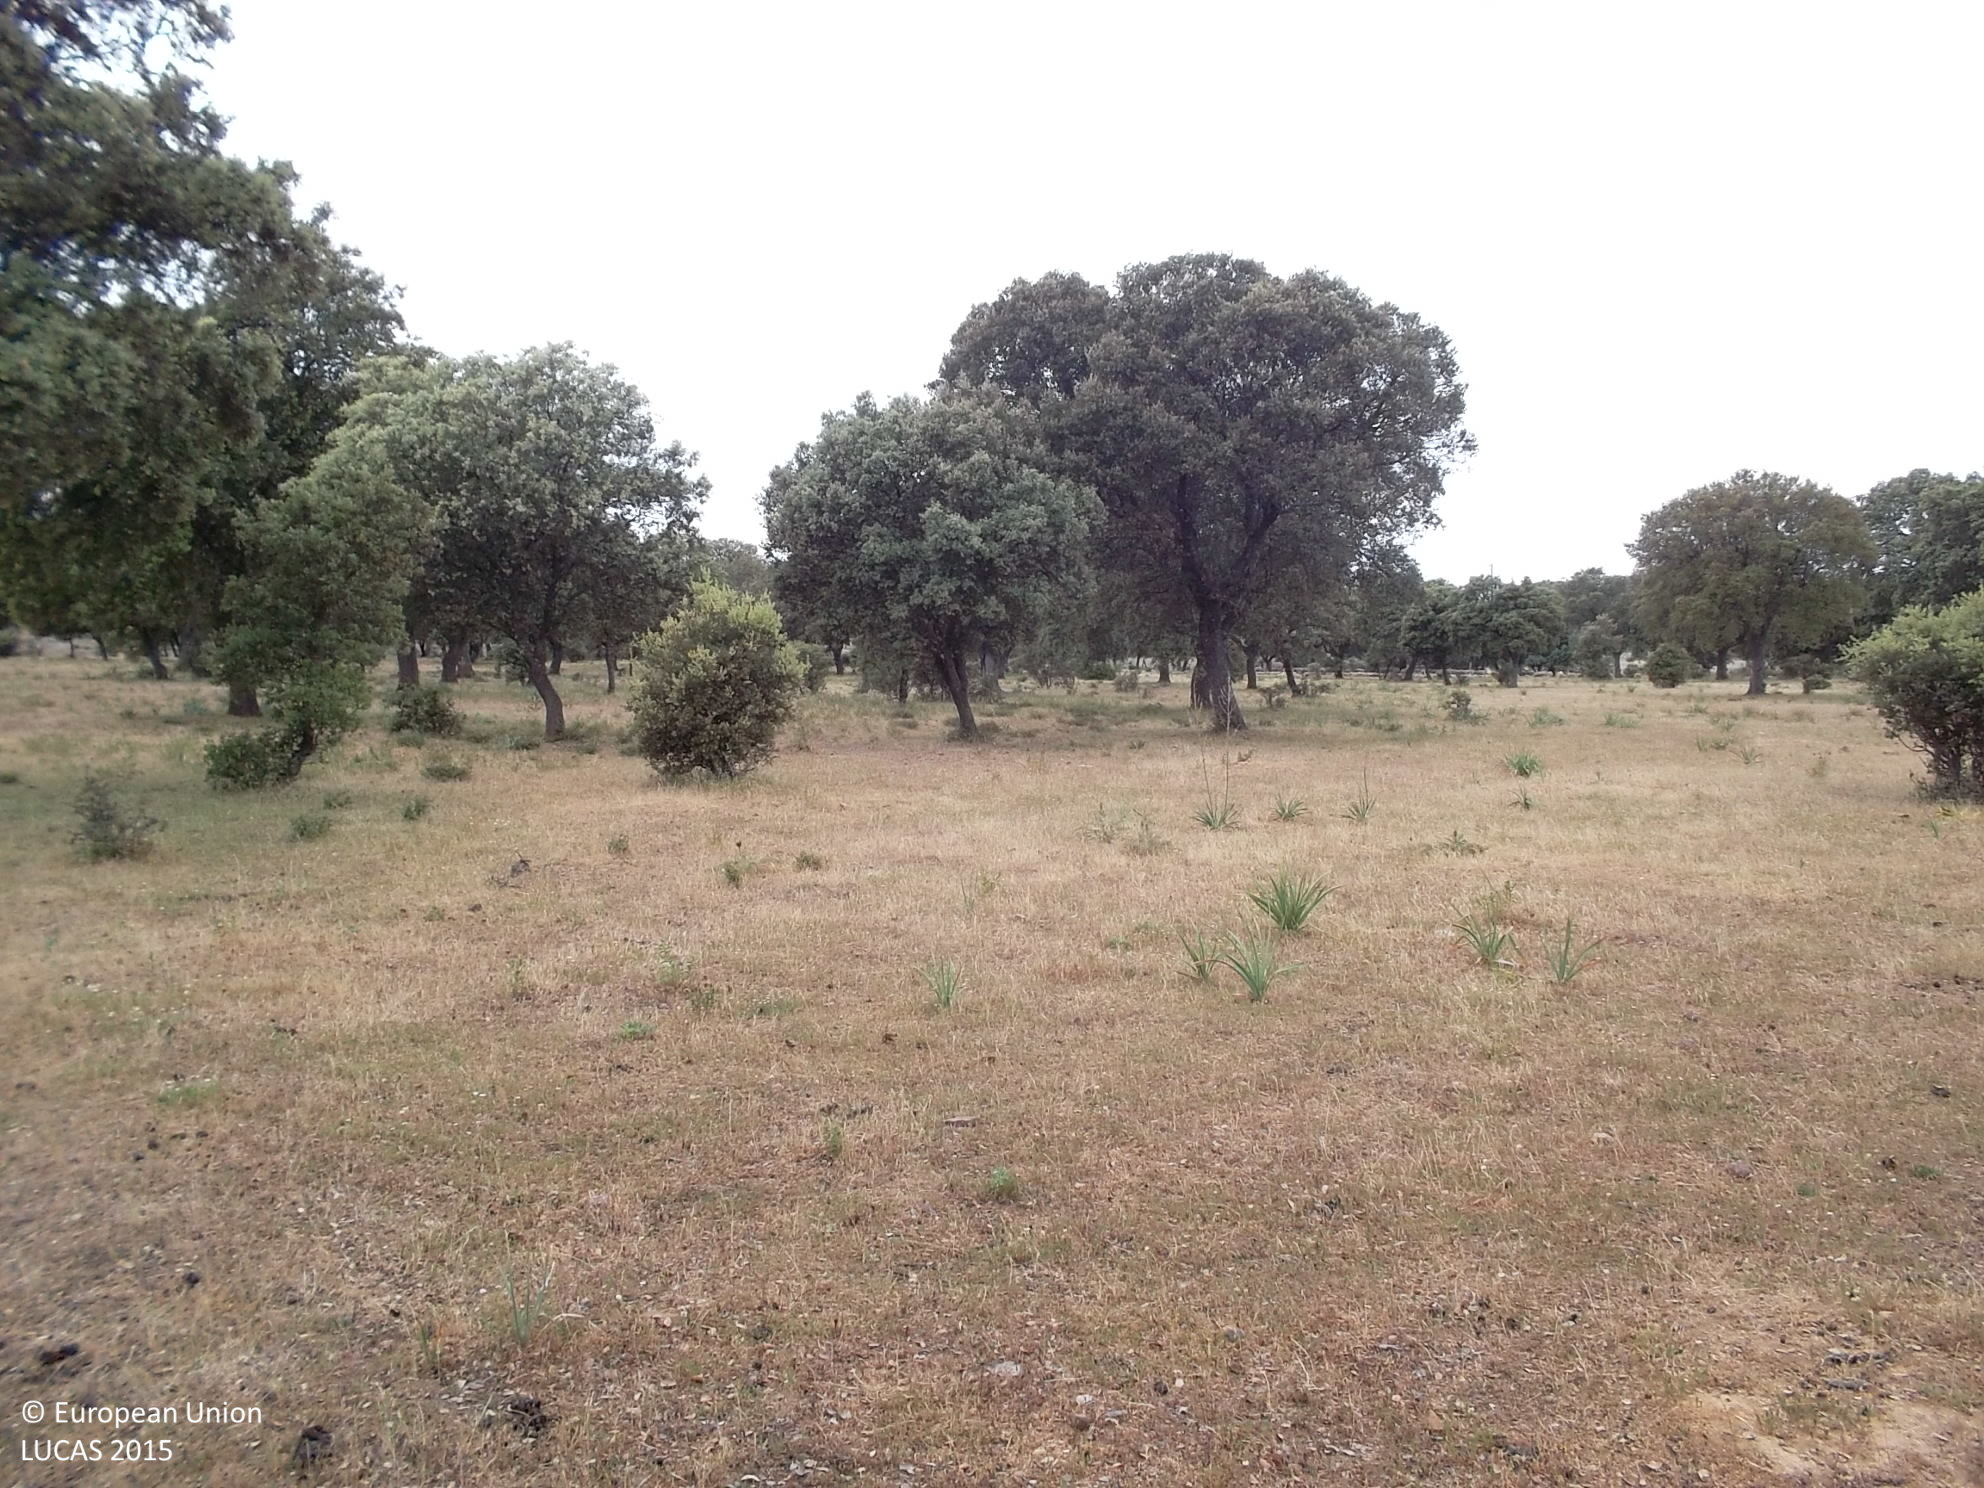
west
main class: Woodland
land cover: Broadleaved woodland
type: broadleaved evergreen forest
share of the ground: 25 - 50 %
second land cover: Spontaneously vegetated surfaces
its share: > 75 %
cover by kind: herbaceous plants 50 %, broadleaved forest trees 40 %, shrubs 10 %
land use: Forestry
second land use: Agriculture (excluding fallow land and kitchen gardens)
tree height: > 5 m
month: May
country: ES
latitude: 38.5710
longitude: -4.4251
